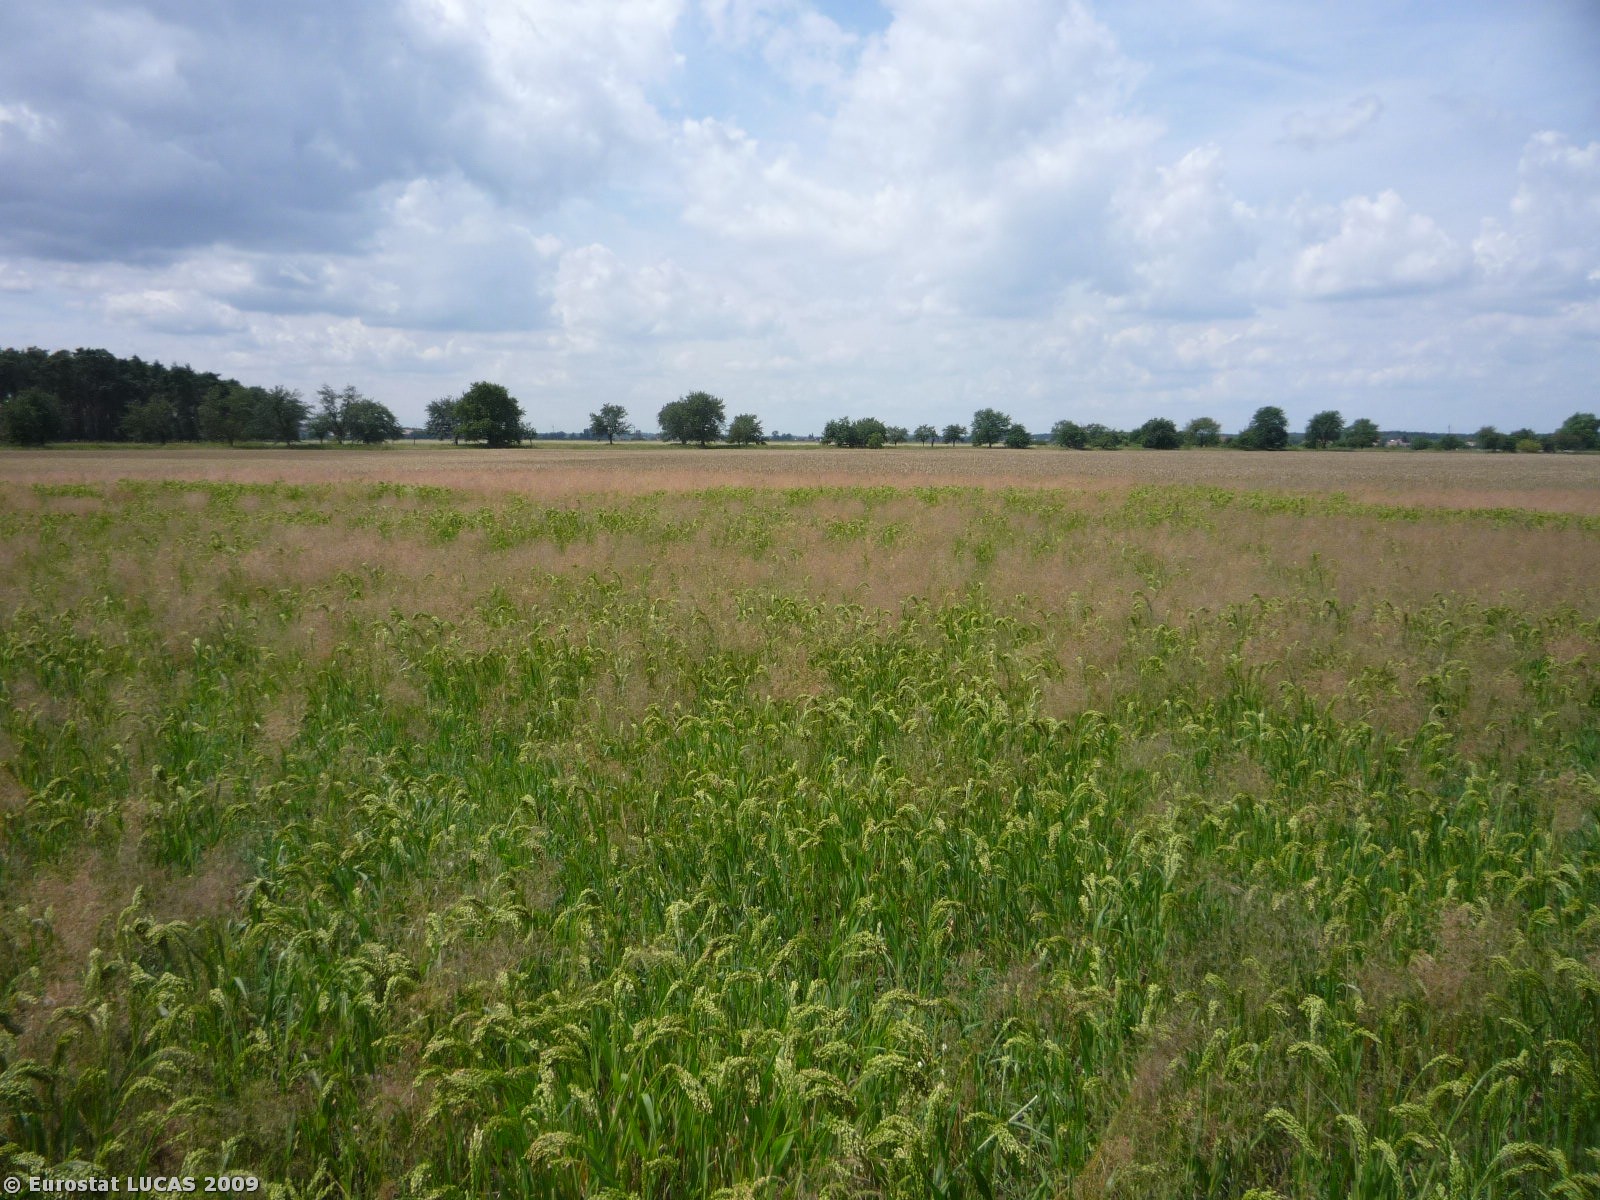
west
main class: Cropland
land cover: Other cereals
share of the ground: > 75 %
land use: Agriculture (excluding fallow land and kitchen gardens)
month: July
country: CZ
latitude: 50.1455
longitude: 15.0265
